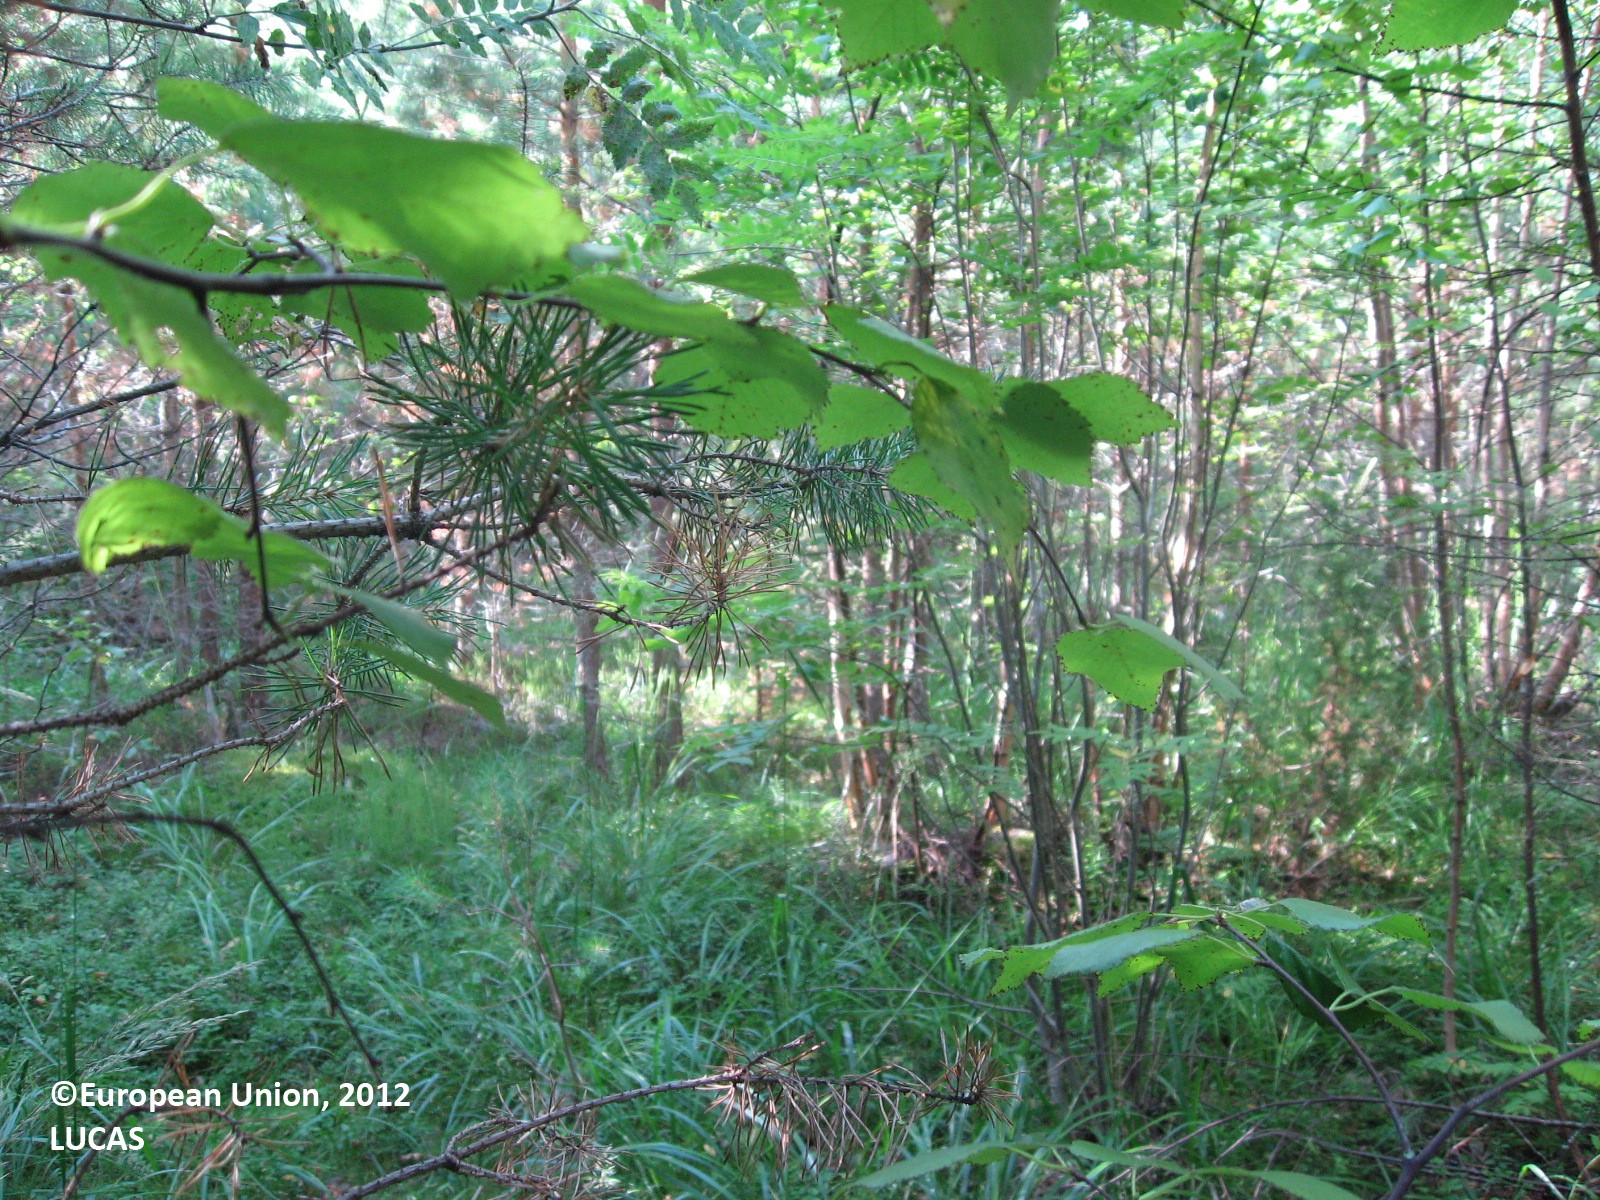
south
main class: Woodland
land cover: Pine dominated mixed woodland
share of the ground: > 75 %
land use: Forestry
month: August
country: FI
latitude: 61.4758
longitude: 25.9578
